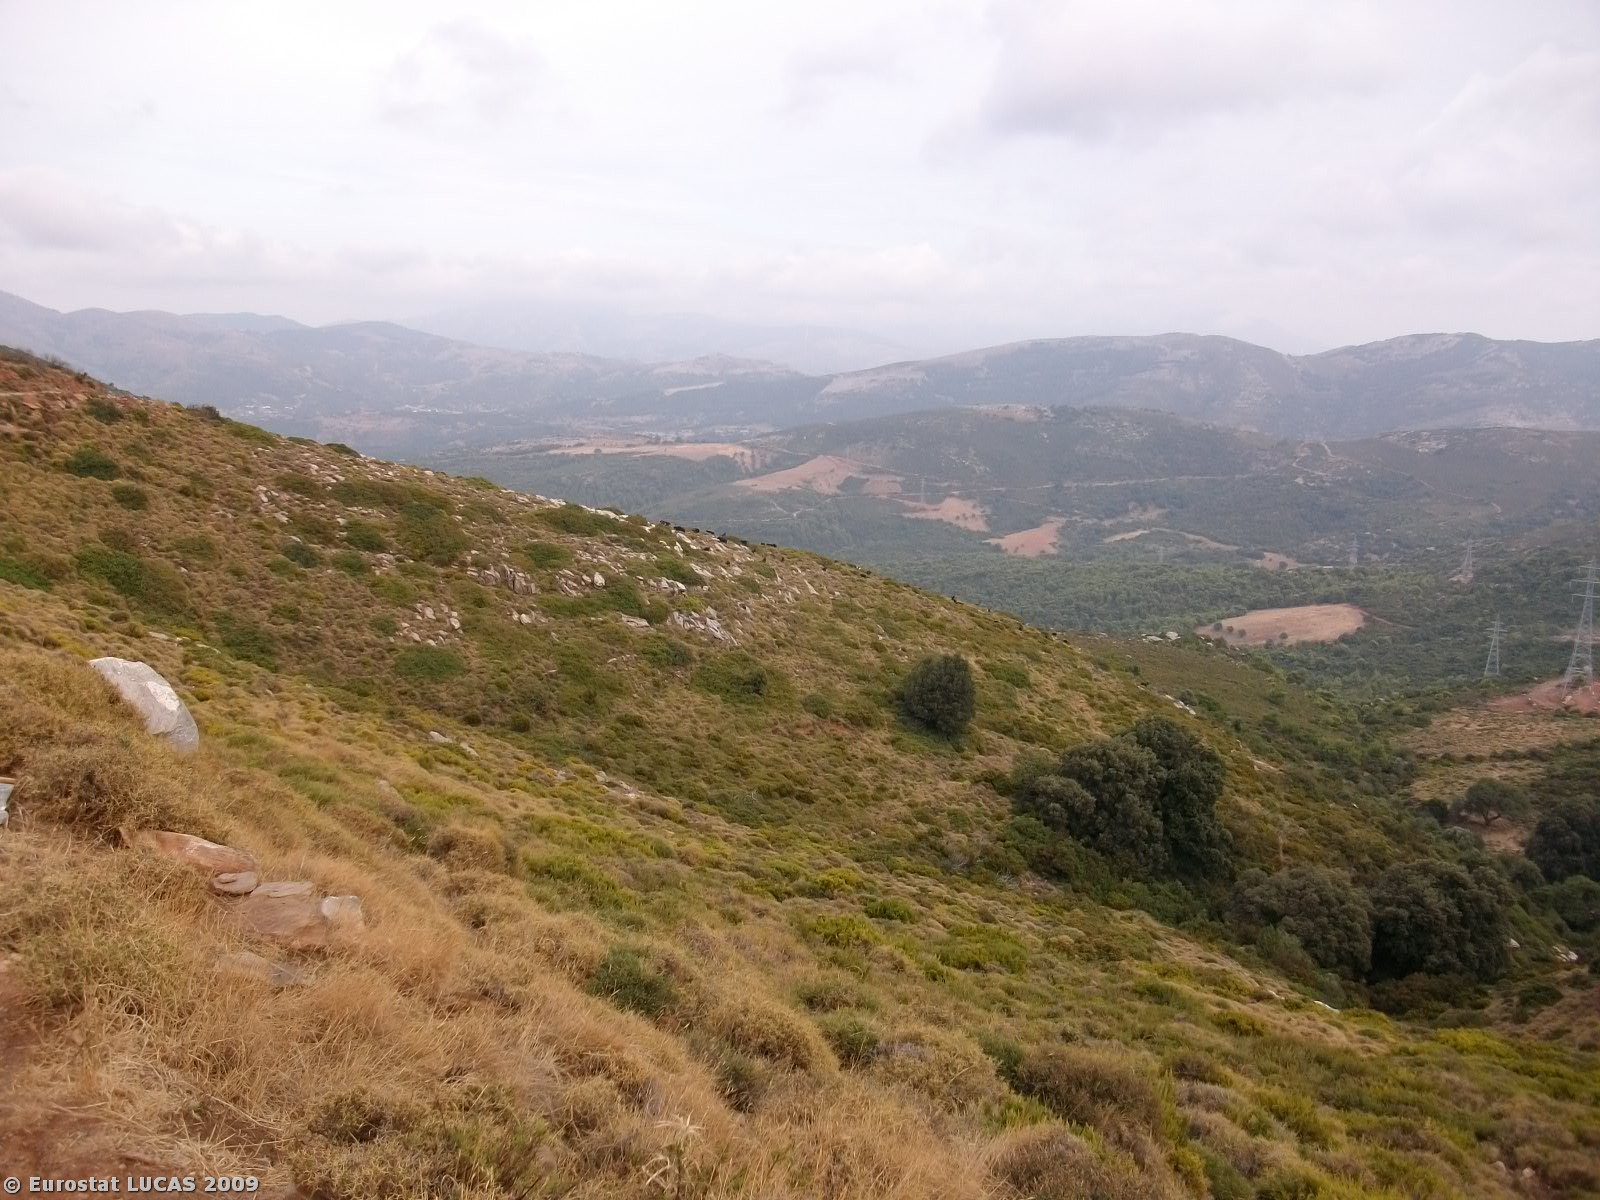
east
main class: Shrubland
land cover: Shrubland without tree cover
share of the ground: > 75 %
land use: Unused
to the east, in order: Shrubland without tree cover
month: September
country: GR
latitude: 38.1188
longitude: 24.2581
